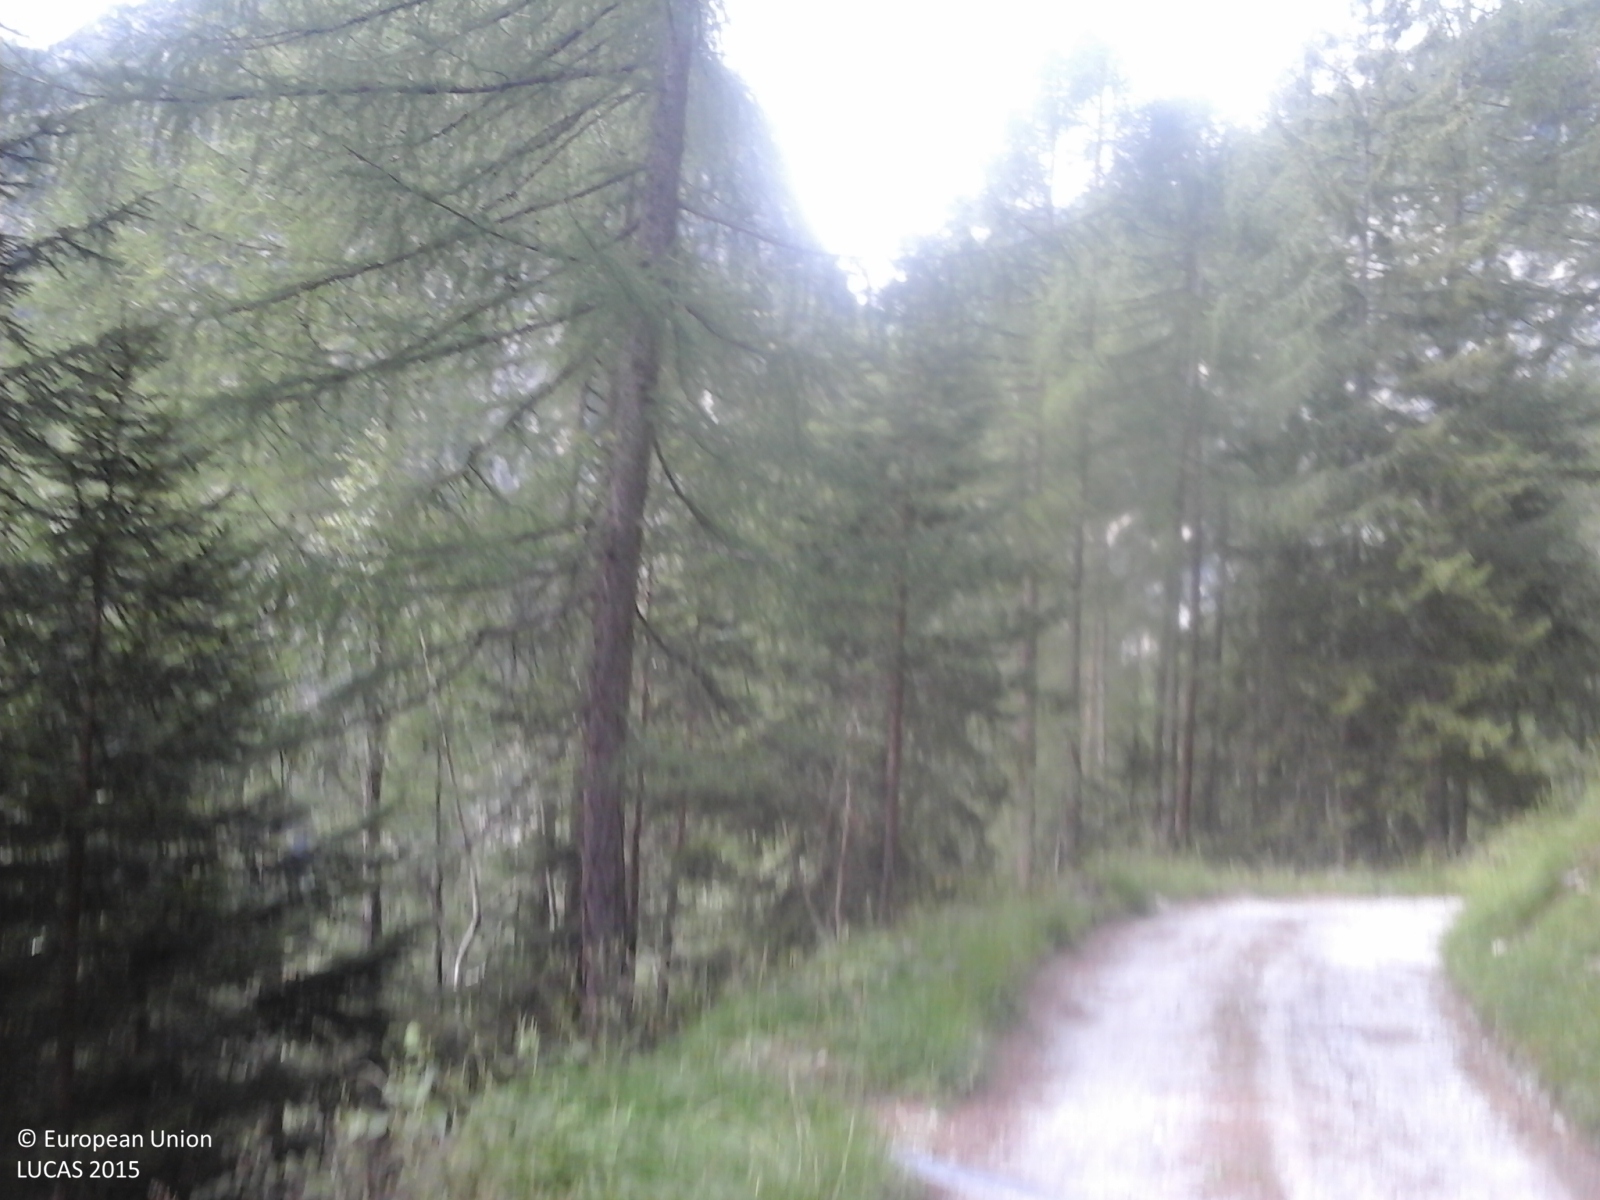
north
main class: Woodland
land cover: Spruce dominated coniferous woodland
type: alpine coniferous forest
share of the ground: > 75 %
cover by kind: coniferous forest trees 100 %
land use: Semi-natural and natural areas not in use
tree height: > 5 m
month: July
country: IT
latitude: 46.2791
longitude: 9.9093
